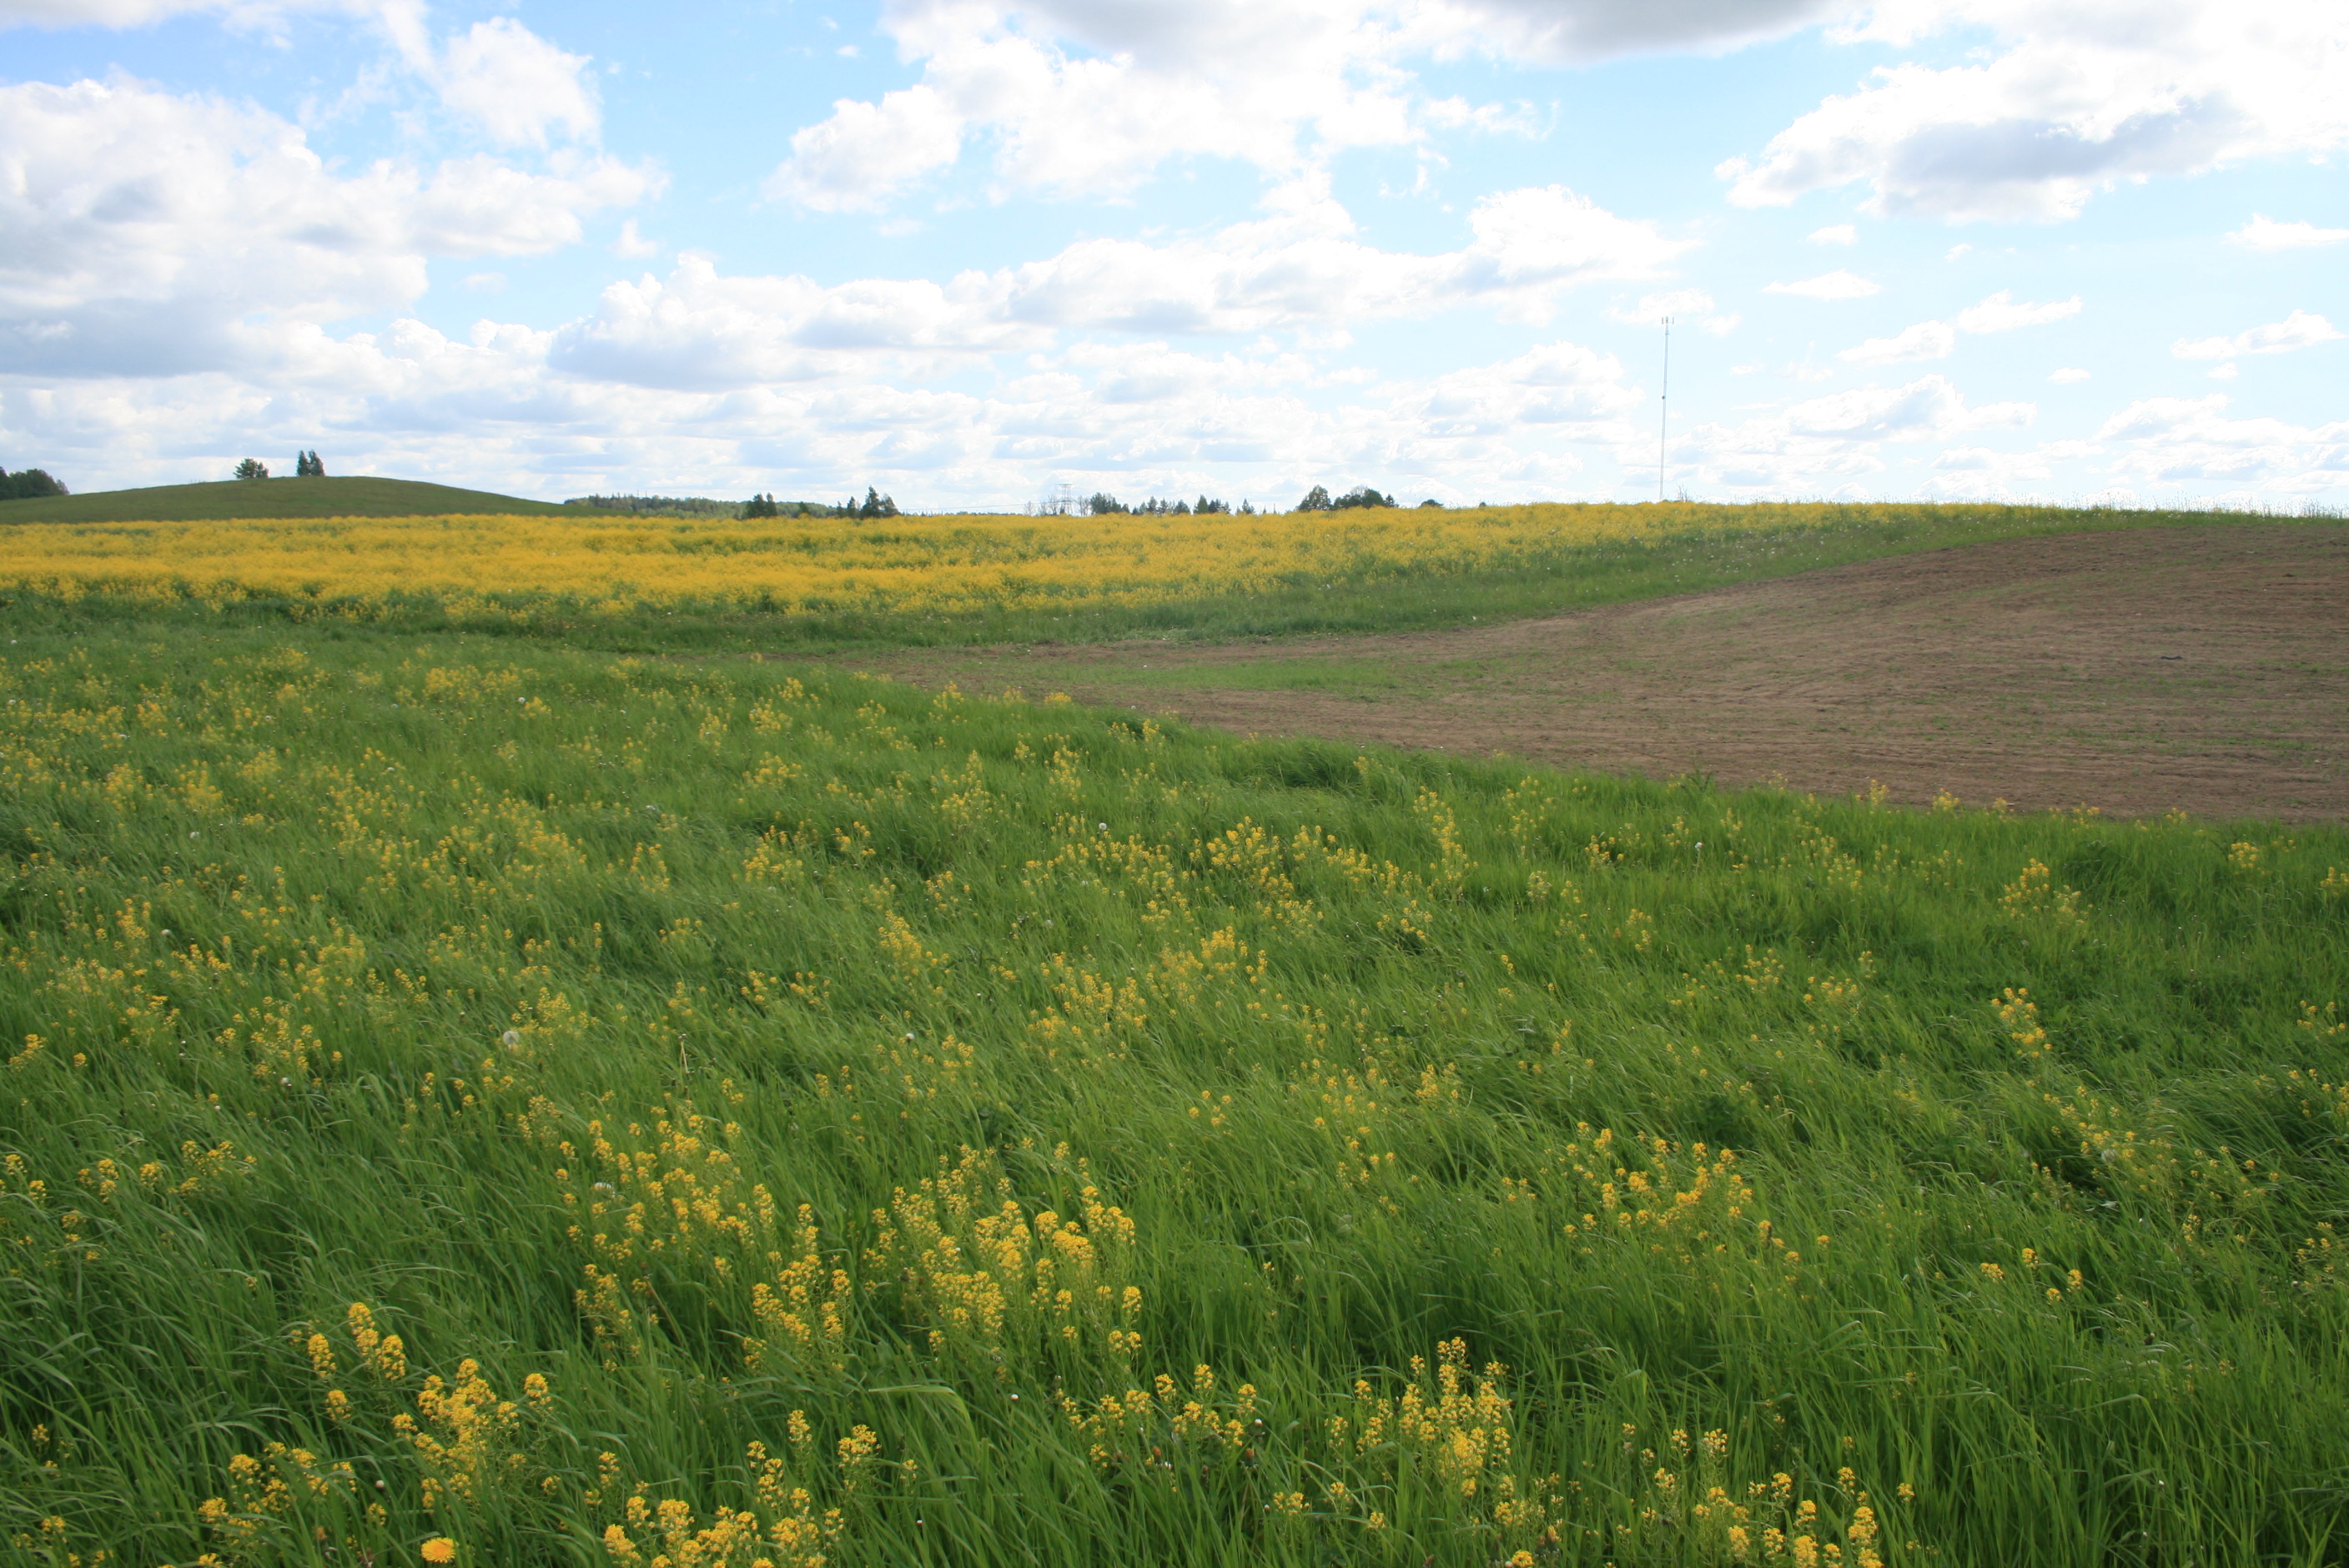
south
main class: Cropland
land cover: Other leguminous and mixtures for fodder
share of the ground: > 75 %
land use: Agriculture (excluding fallow land and kitchen gardens)
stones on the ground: < 10 %
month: May
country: LT
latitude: 55.9838
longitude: 22.0247
